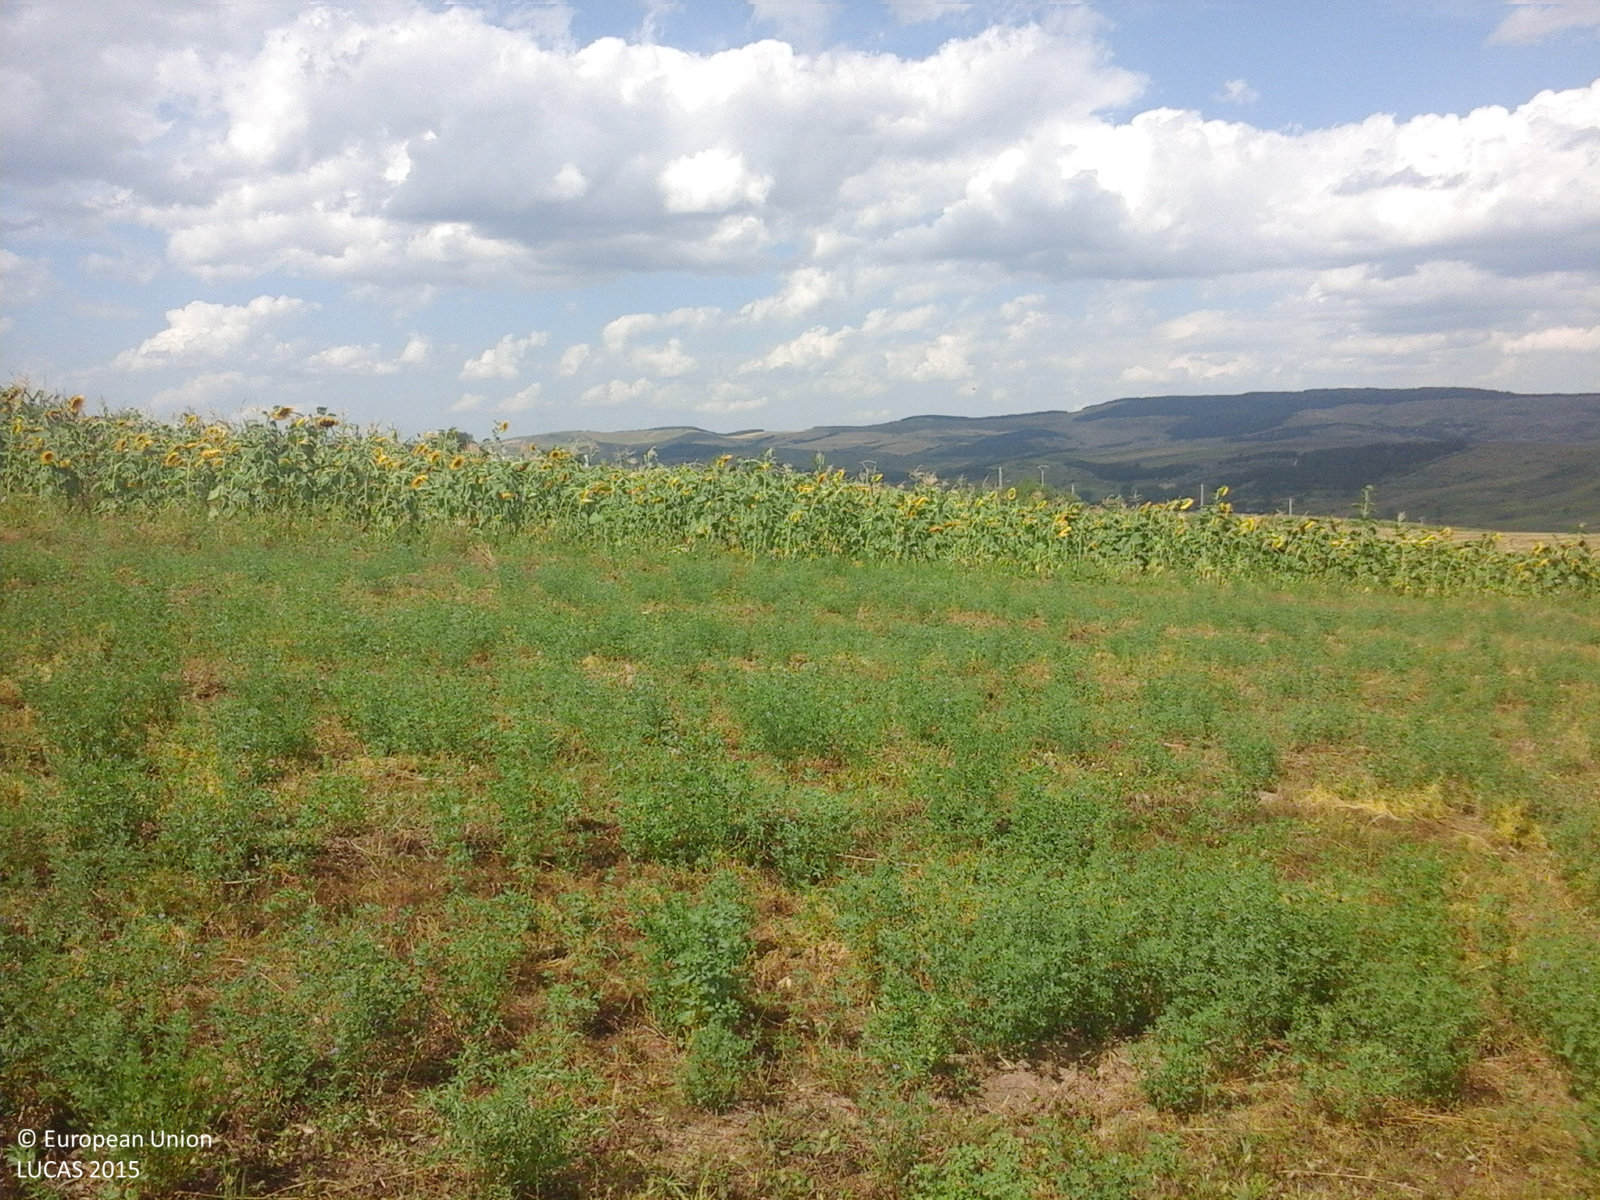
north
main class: Cropland
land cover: Lucerne
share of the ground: > 75 %
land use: Agriculture (excluding fallow land and kitchen gardens)
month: July
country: RO
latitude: 46.5727
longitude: 27.3694
